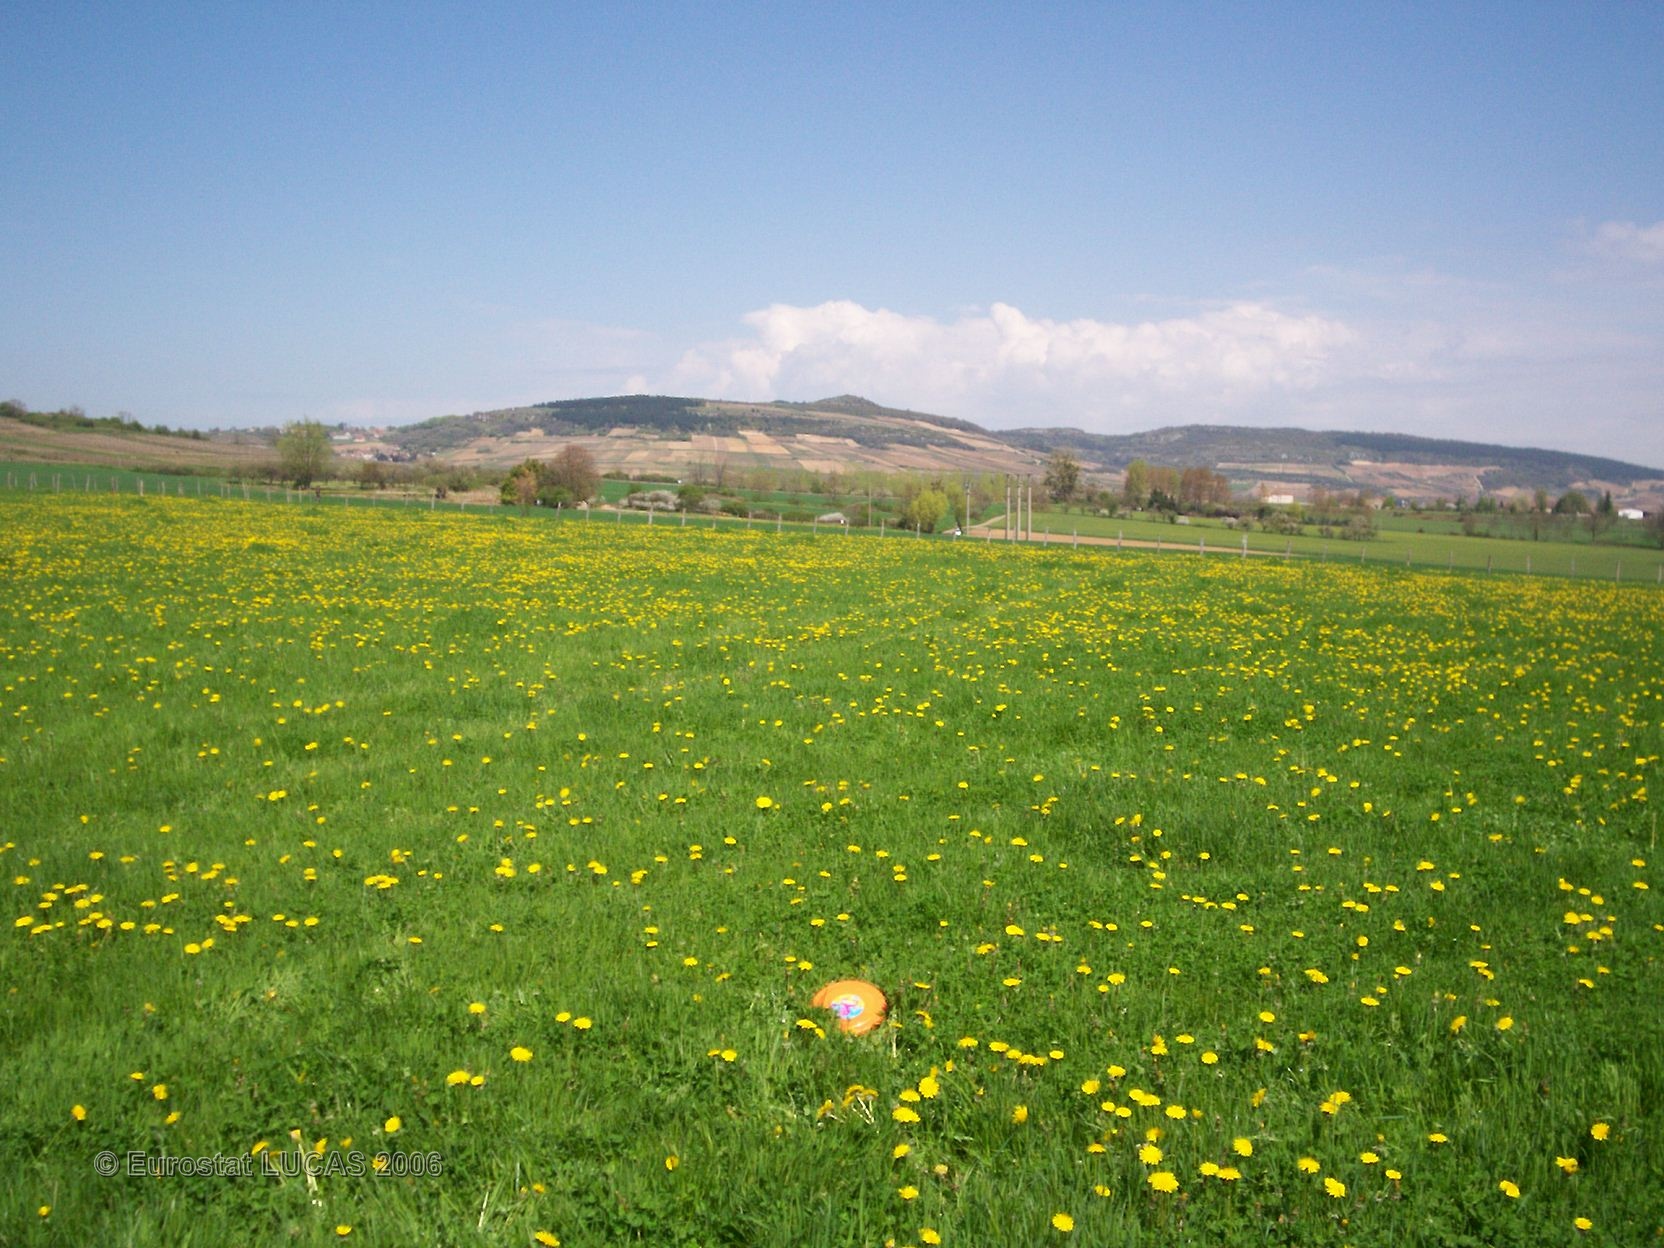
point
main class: Grassland
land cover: Grassland without tree/shrub cover
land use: Agriculture (excluding fallow land and kitchen gardens)
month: April
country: FR
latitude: 46.8856
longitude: 4.6596
